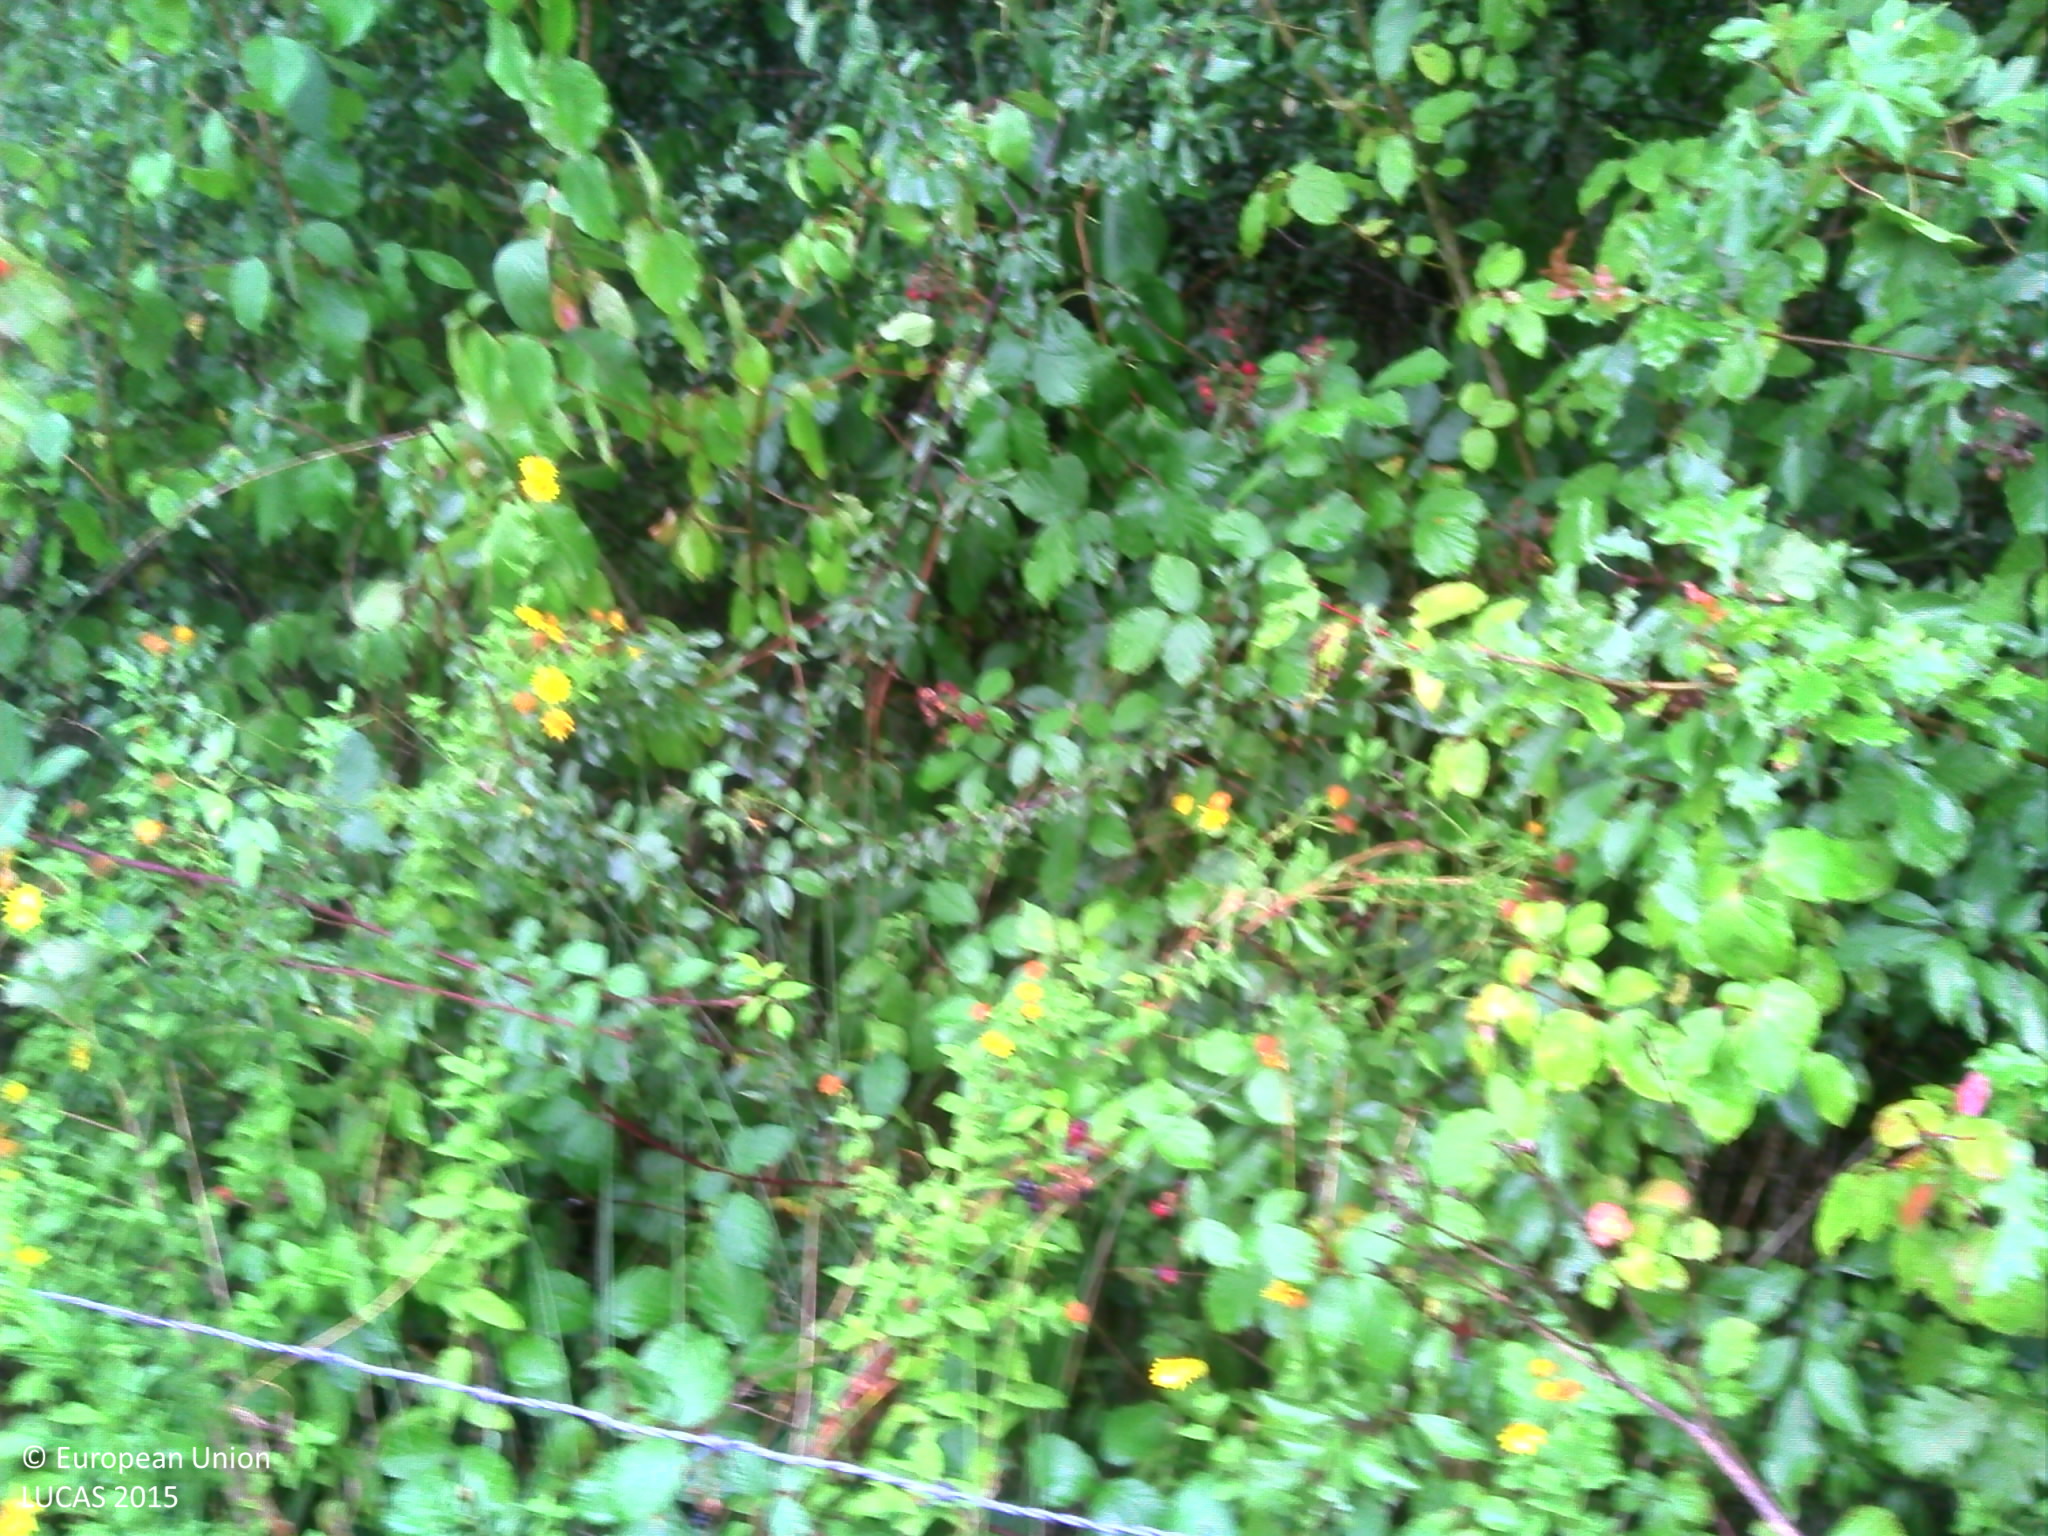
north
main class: Woodland
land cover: Broadleaved woodland
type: mesophytic deciduous forest
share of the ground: > 75 %
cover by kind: broadleaved forest trees 70 %, shrubs 20 %, herbaceous plants 10 %
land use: Semi-natural and natural areas not in use
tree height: > 5 m
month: September
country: FR
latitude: 47.2159
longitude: 6.0537
